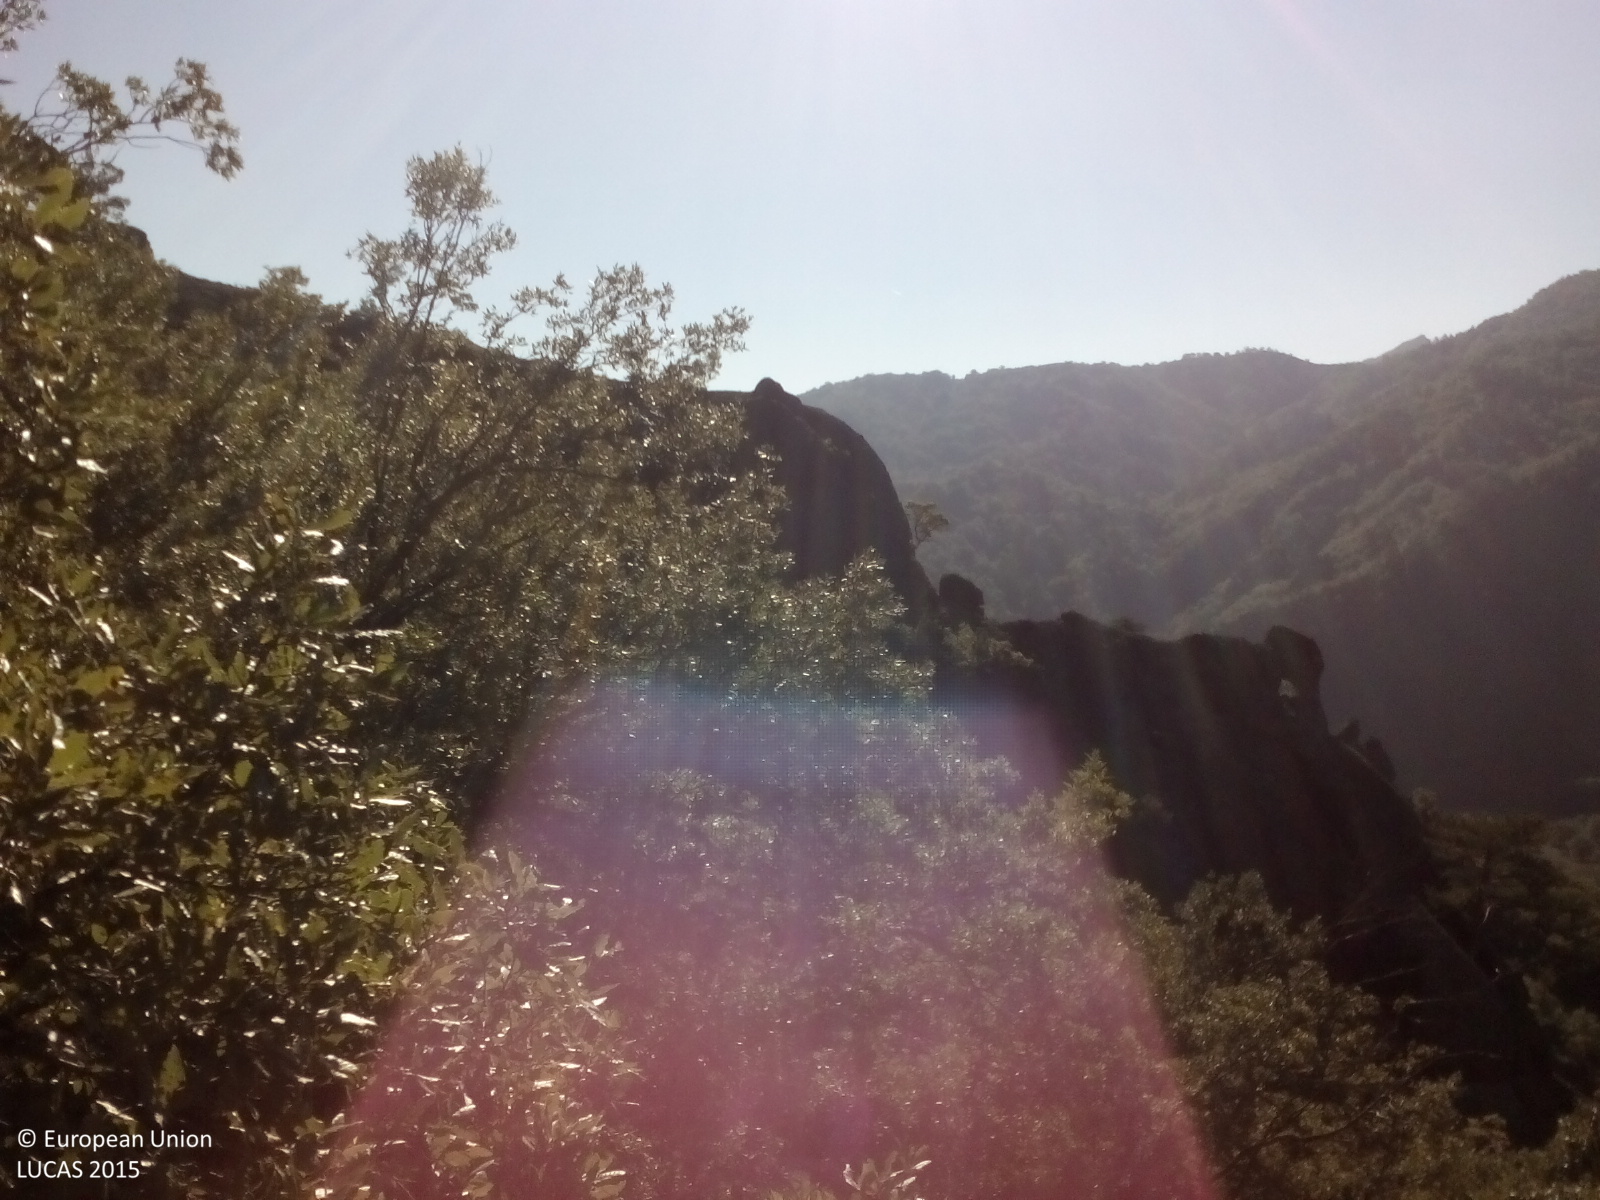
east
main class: Woodland
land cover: Broadleaved woodland
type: thermophilous deciduous forest
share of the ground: 25 - 50 %
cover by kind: broadleaved forest trees 45 %, unconsolidated bare surface 30 %, herbaceous plants 15 %, shrubs 10 %
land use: Forestry
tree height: > 5 m
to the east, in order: Broadleaved woodland; Grassland with sparse tree/shrub cover; Tracks; Broadleaved woodland; Rock outcrops; Tracks; Broadleaved woodland
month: September
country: GR
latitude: 39.9997
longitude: 21.2644
